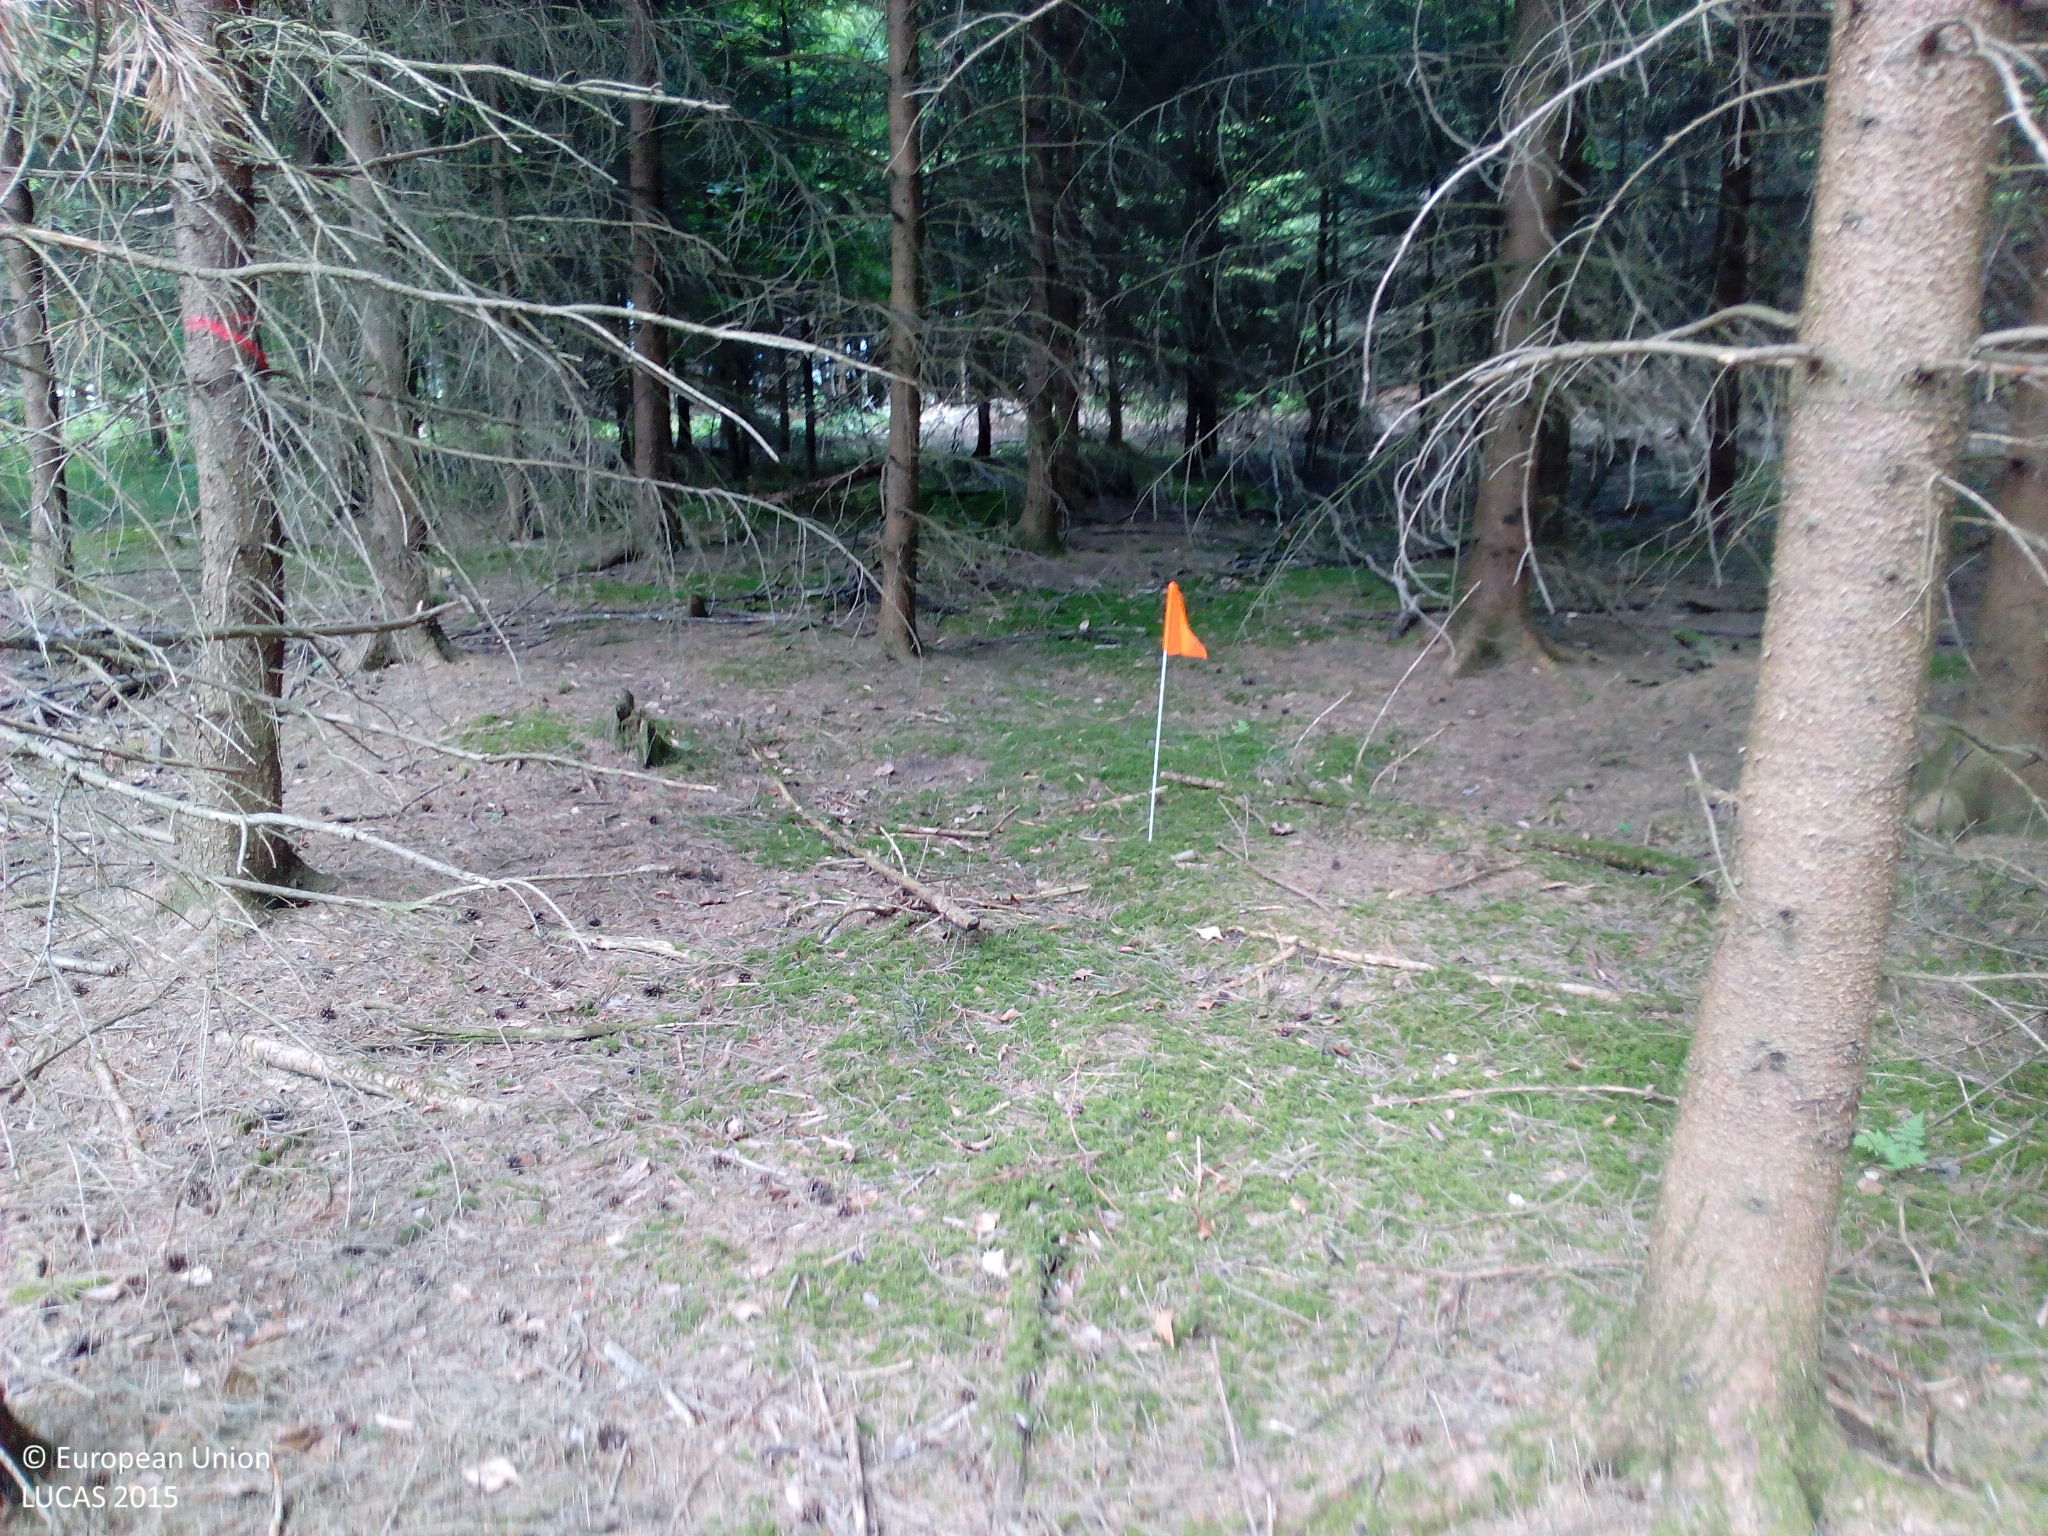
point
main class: Woodland
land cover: Spruce dominated coniferous woodland
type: hemiboreal forest and nemoral coniferous forest and mixed broadleaved-coniferous forest
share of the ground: > 75 %
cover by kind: coniferous forest trees 80 %, lichens and mosses 10 %, consolidated bare surface 10 %
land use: Forestry
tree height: > 5 m
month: June
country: DE
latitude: 48.5935
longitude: 12.3991
